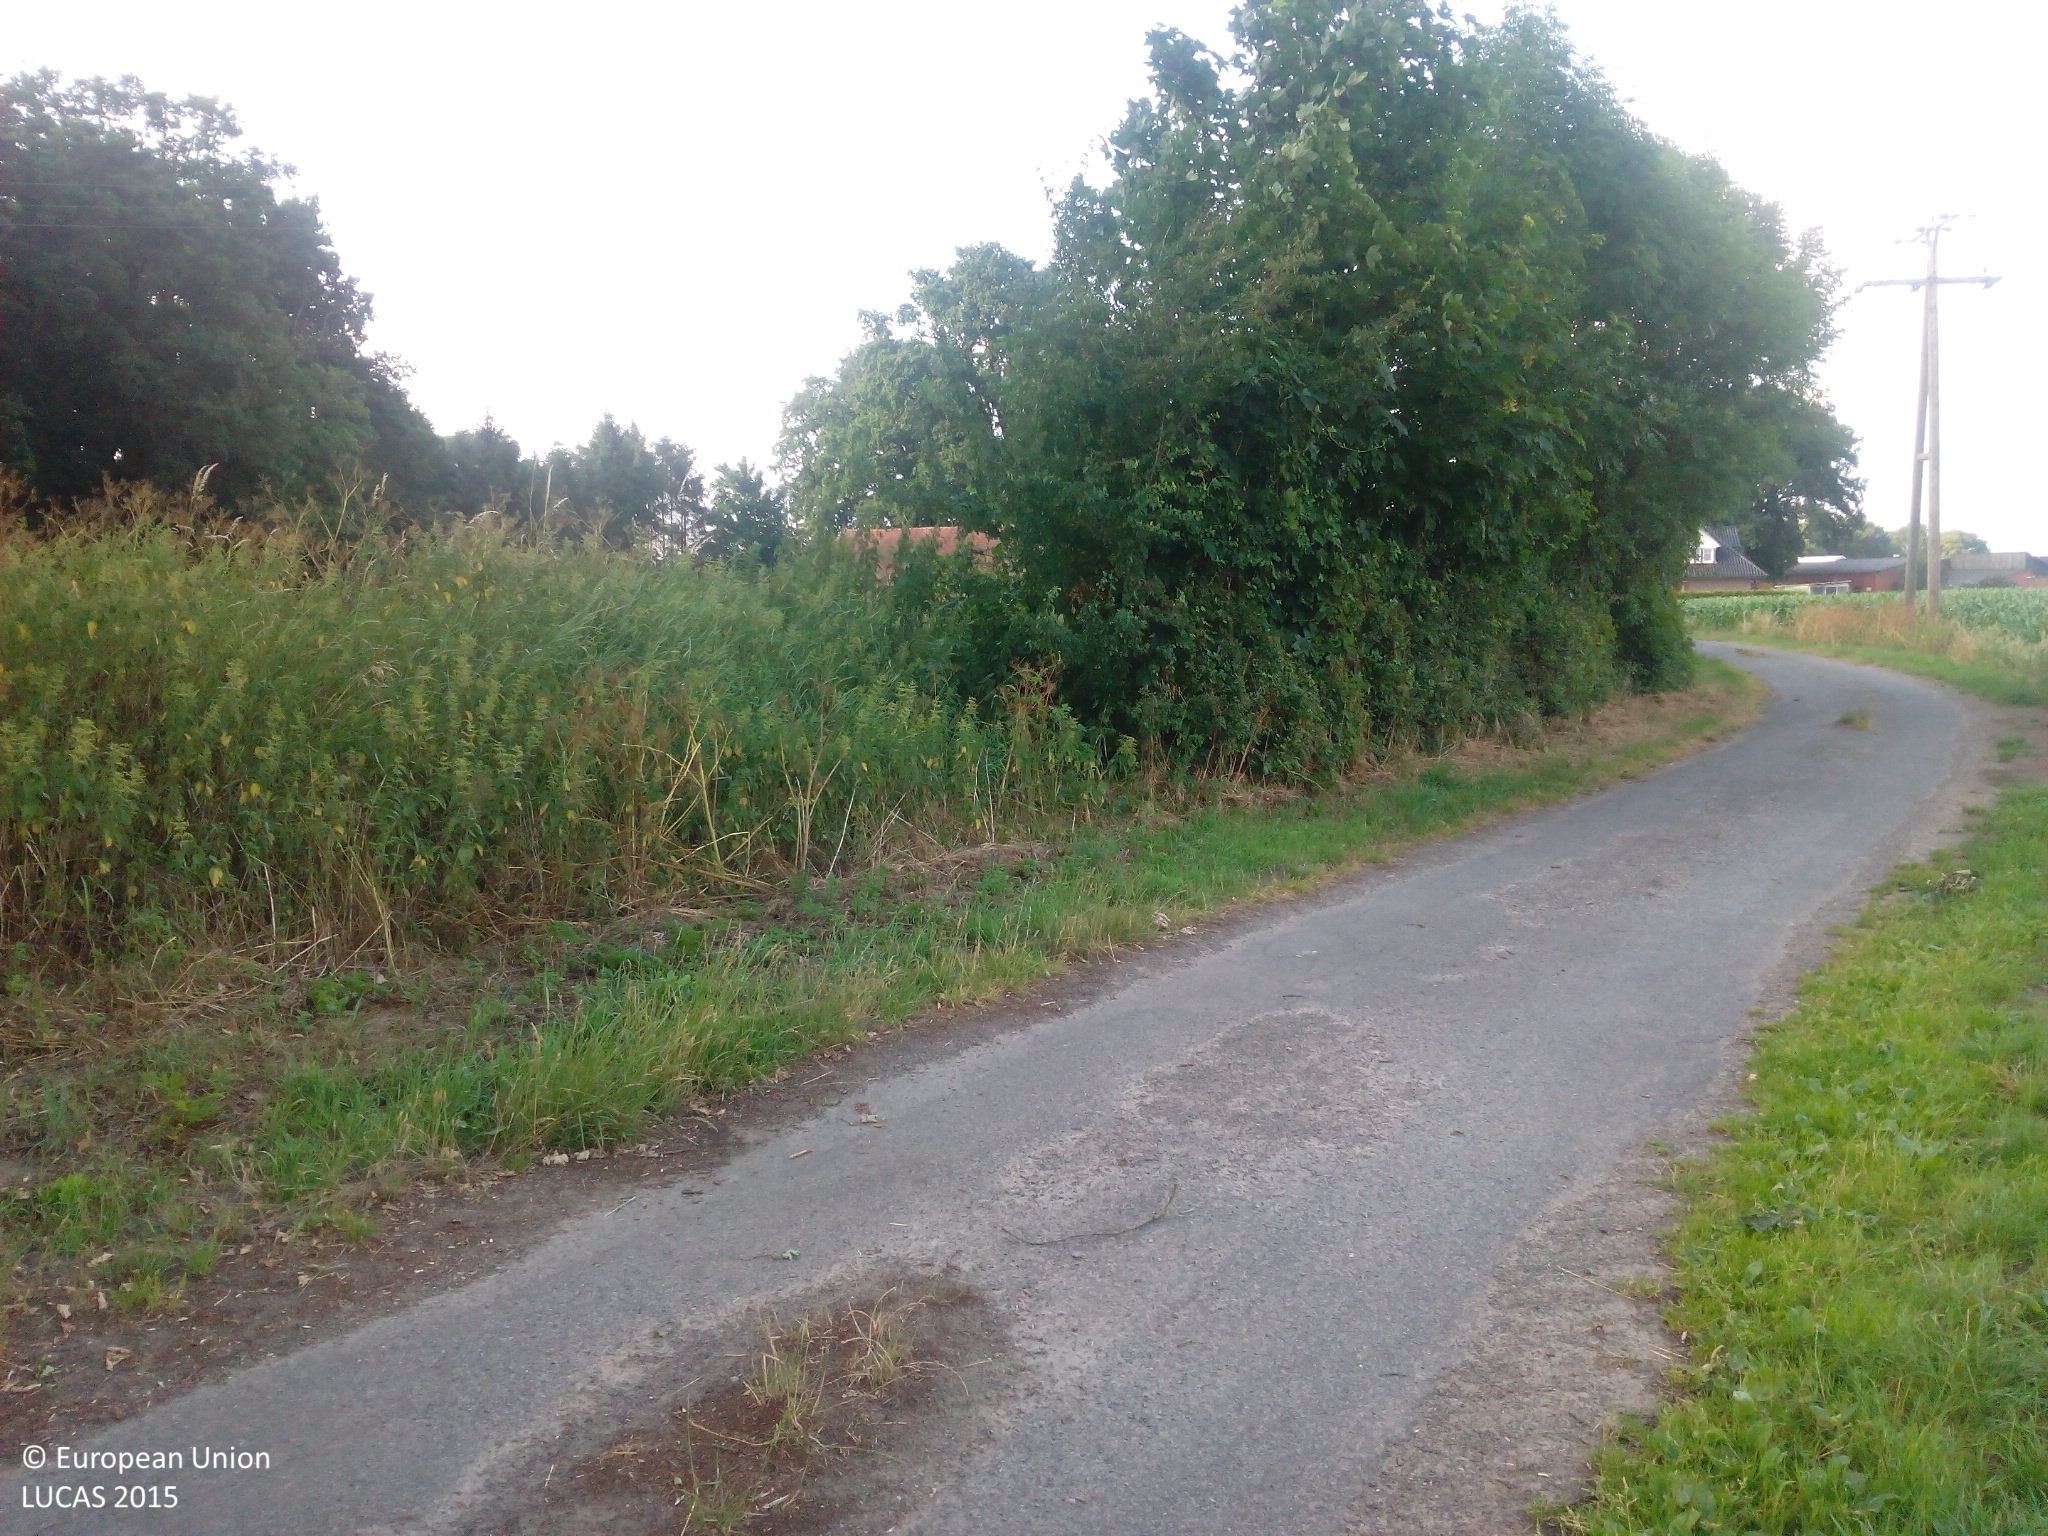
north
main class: Cropland
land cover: Maize
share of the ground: > 75 %
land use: Agriculture (excluding fallow land and kitchen gardens)
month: July
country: DE
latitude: 52.6557
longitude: 7.4429
